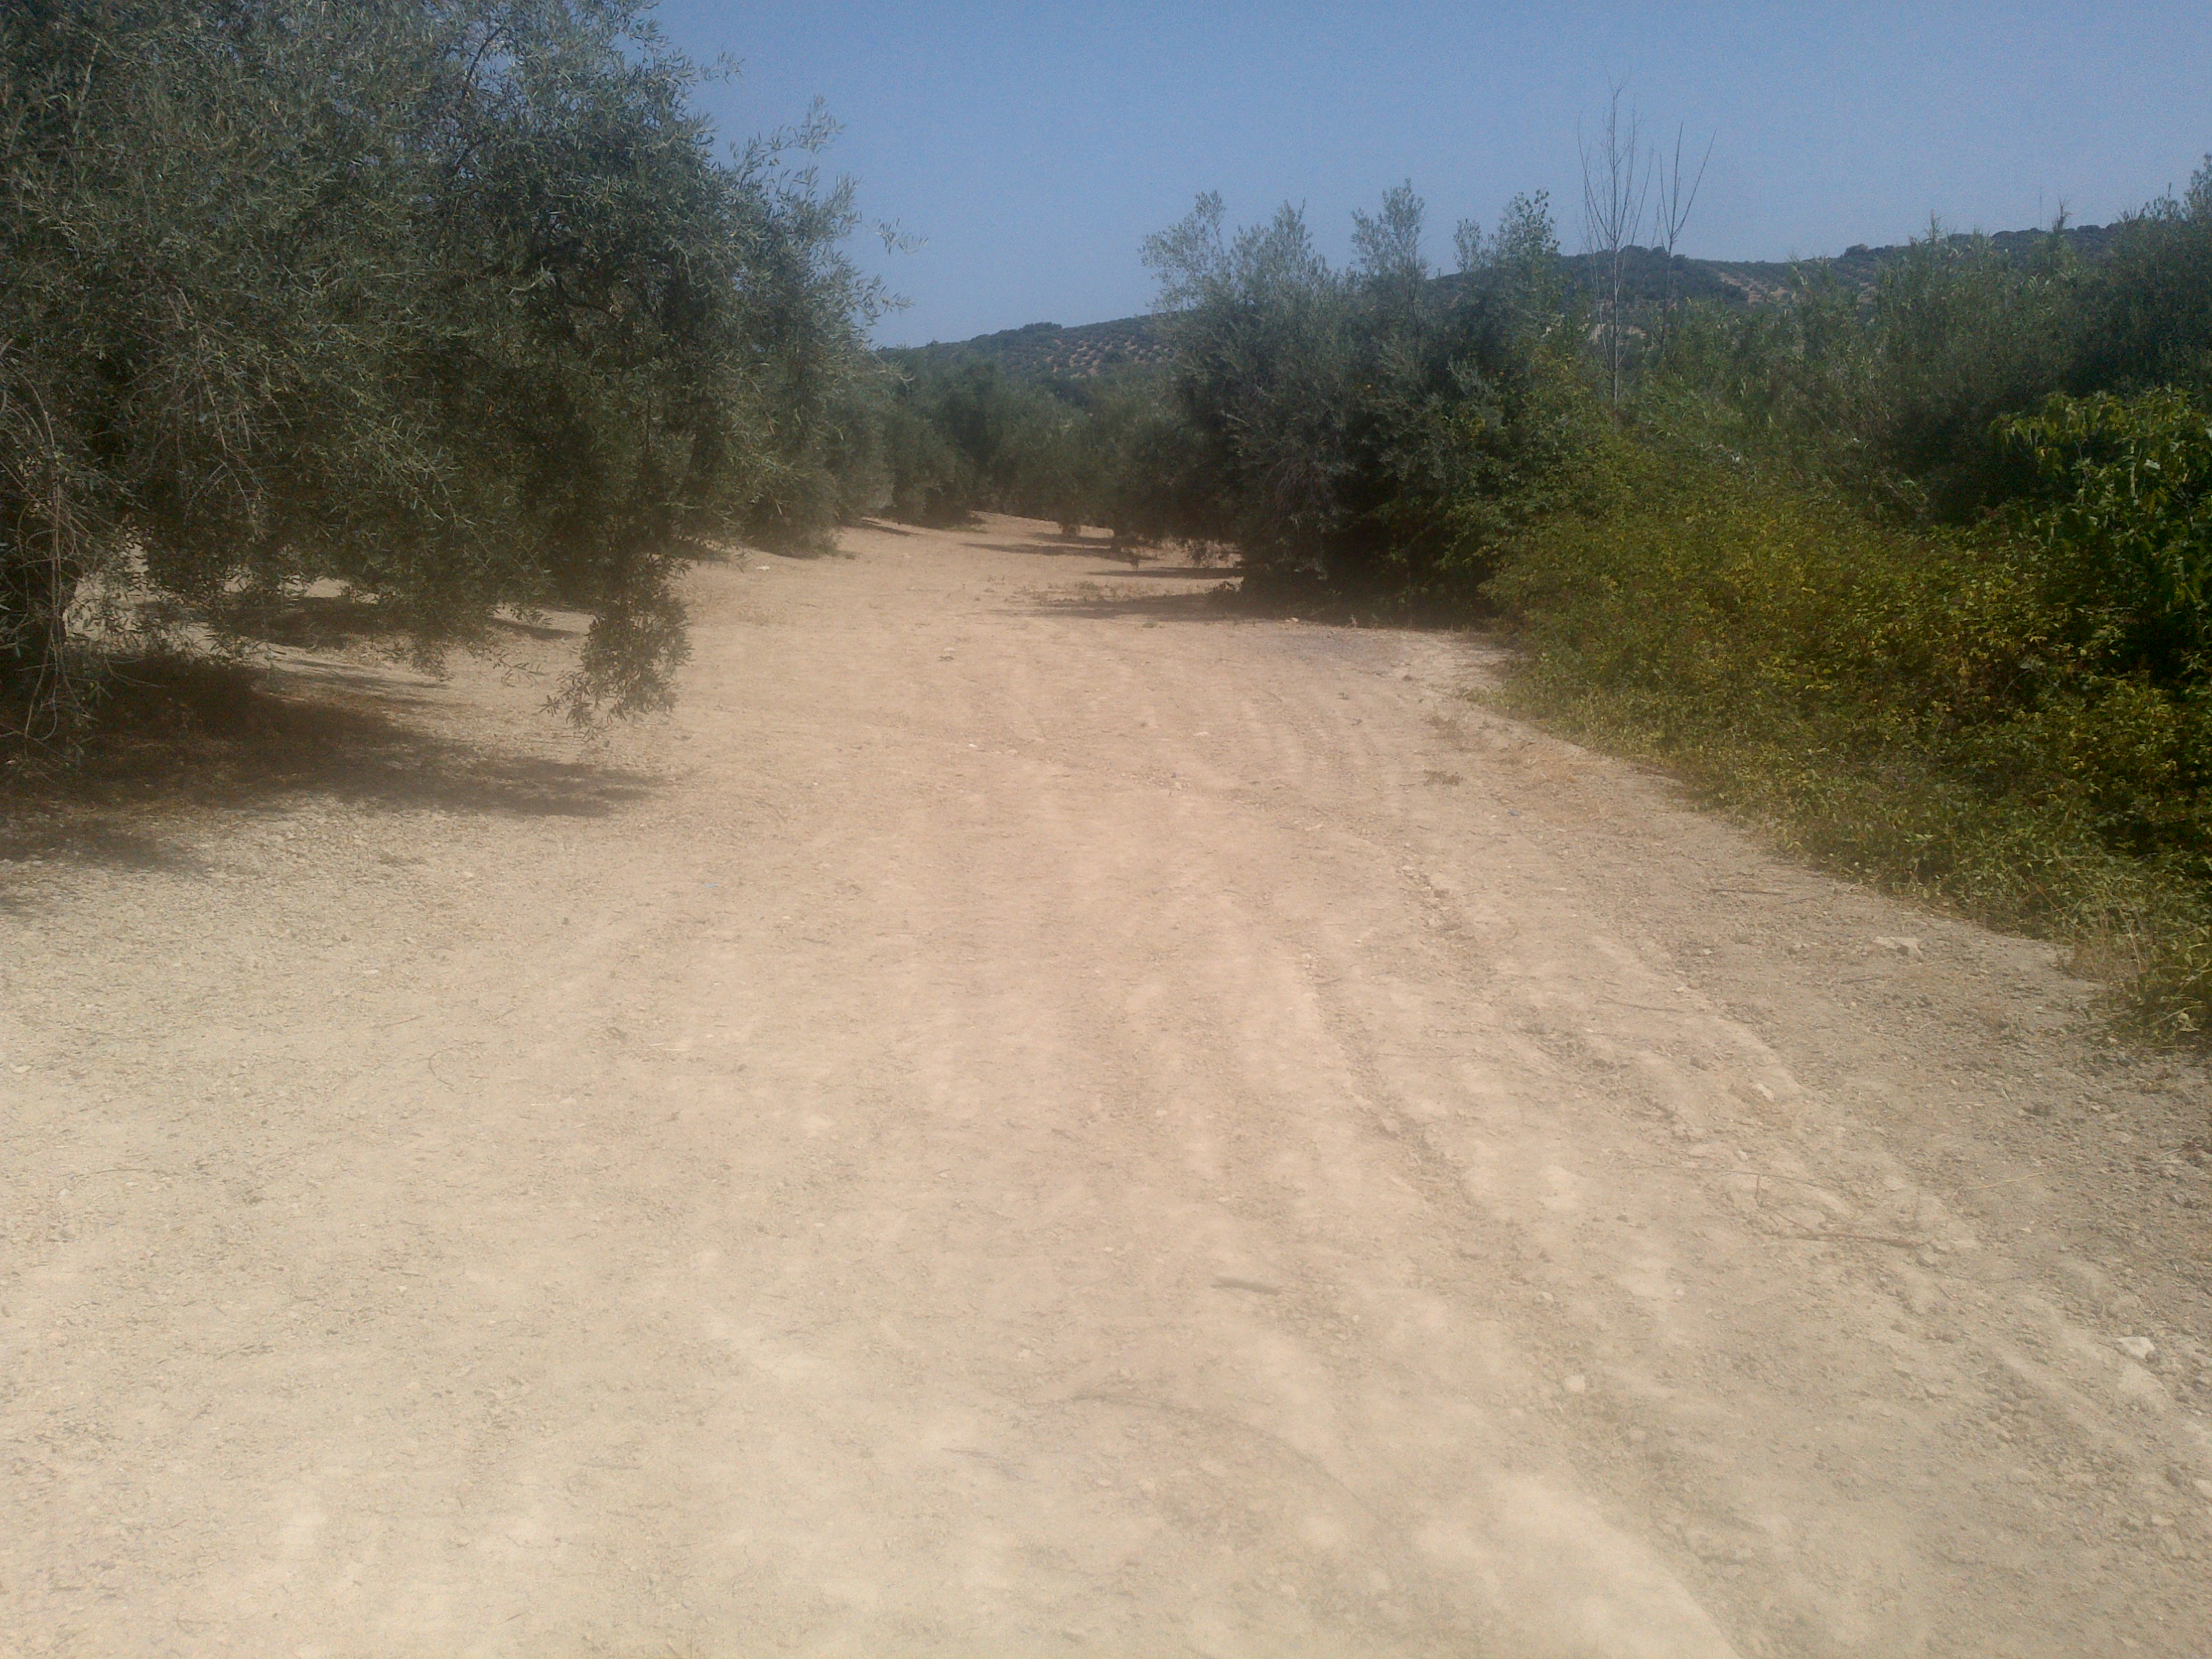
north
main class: Cropland
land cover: Olive groves
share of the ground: 50 - 75 %
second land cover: Other bare soil
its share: > 75 %
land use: Agriculture (excluding fallow land and kitchen gardens)
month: July
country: ES
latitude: 37.5409
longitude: -4.4343
